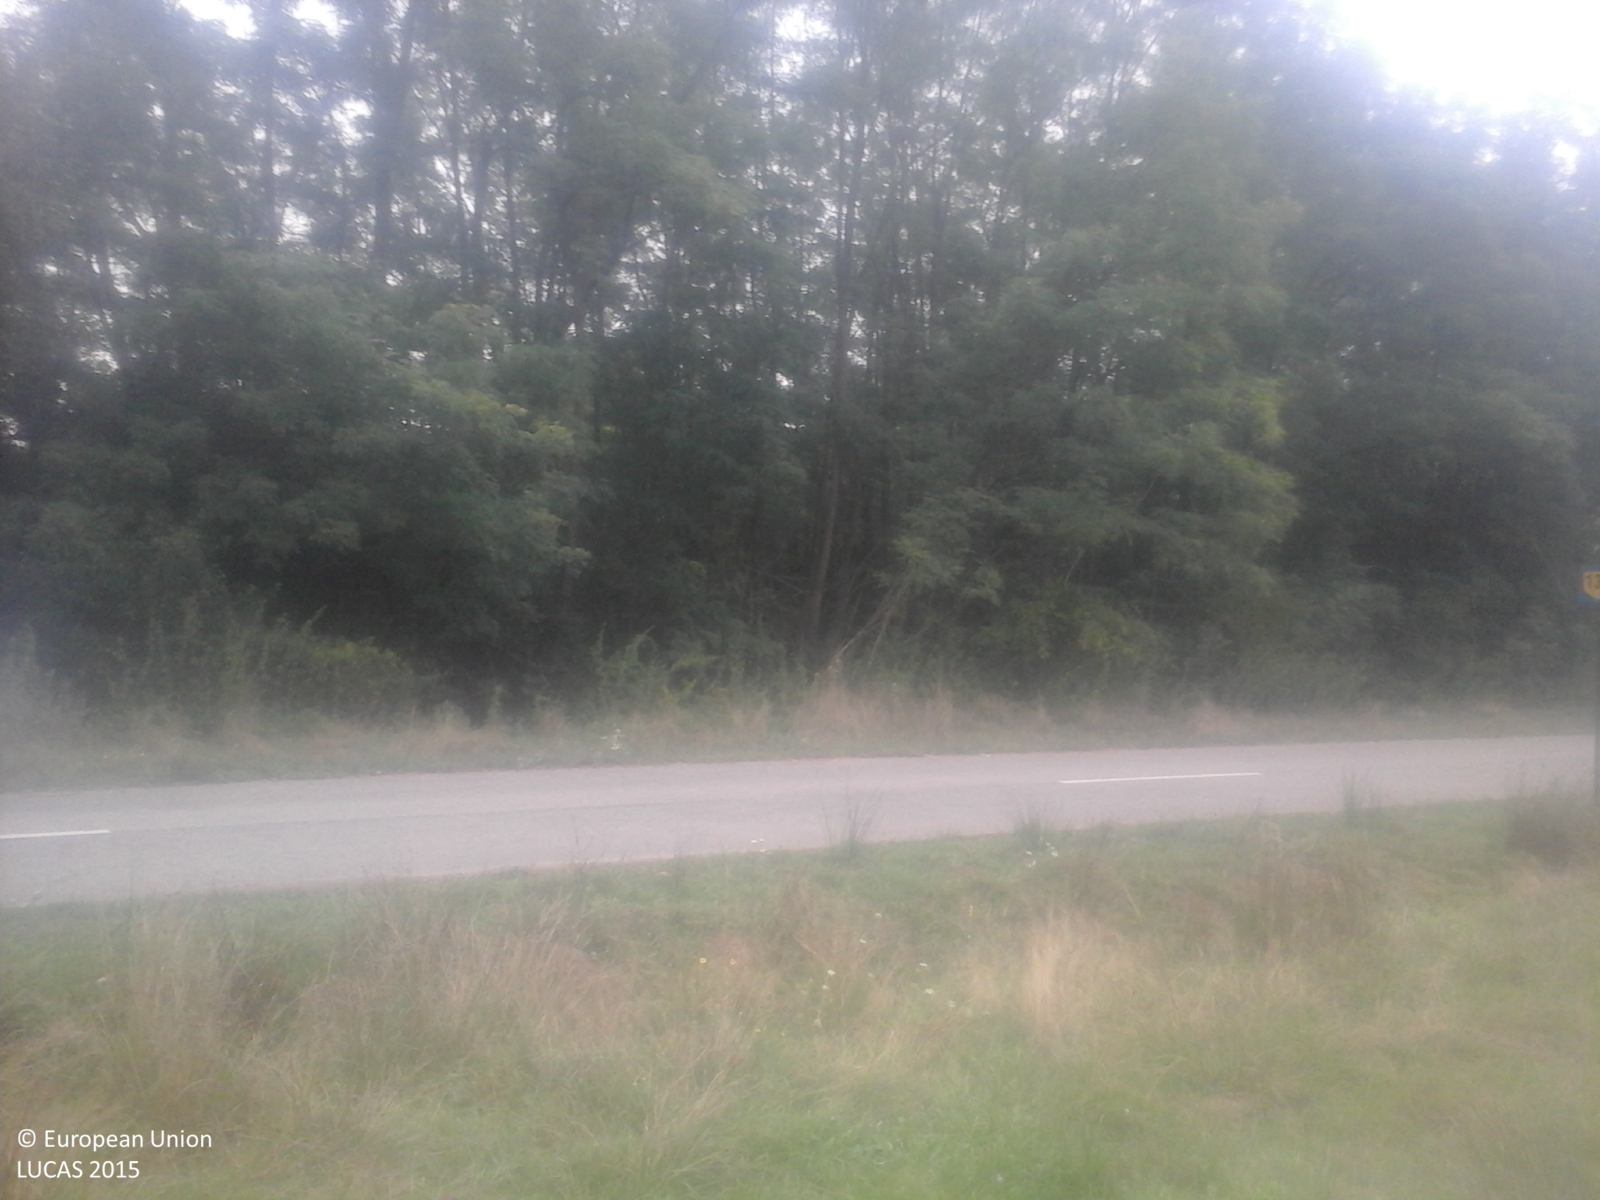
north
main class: Grassland
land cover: Grassland without tree/shrub cover
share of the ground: > 75 %
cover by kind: herbaceous plants 100 %
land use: Agriculture (excluding fallow land and kitchen gardens)
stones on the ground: < 10 %
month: September
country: RO
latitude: 45.5348
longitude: 21.9342
